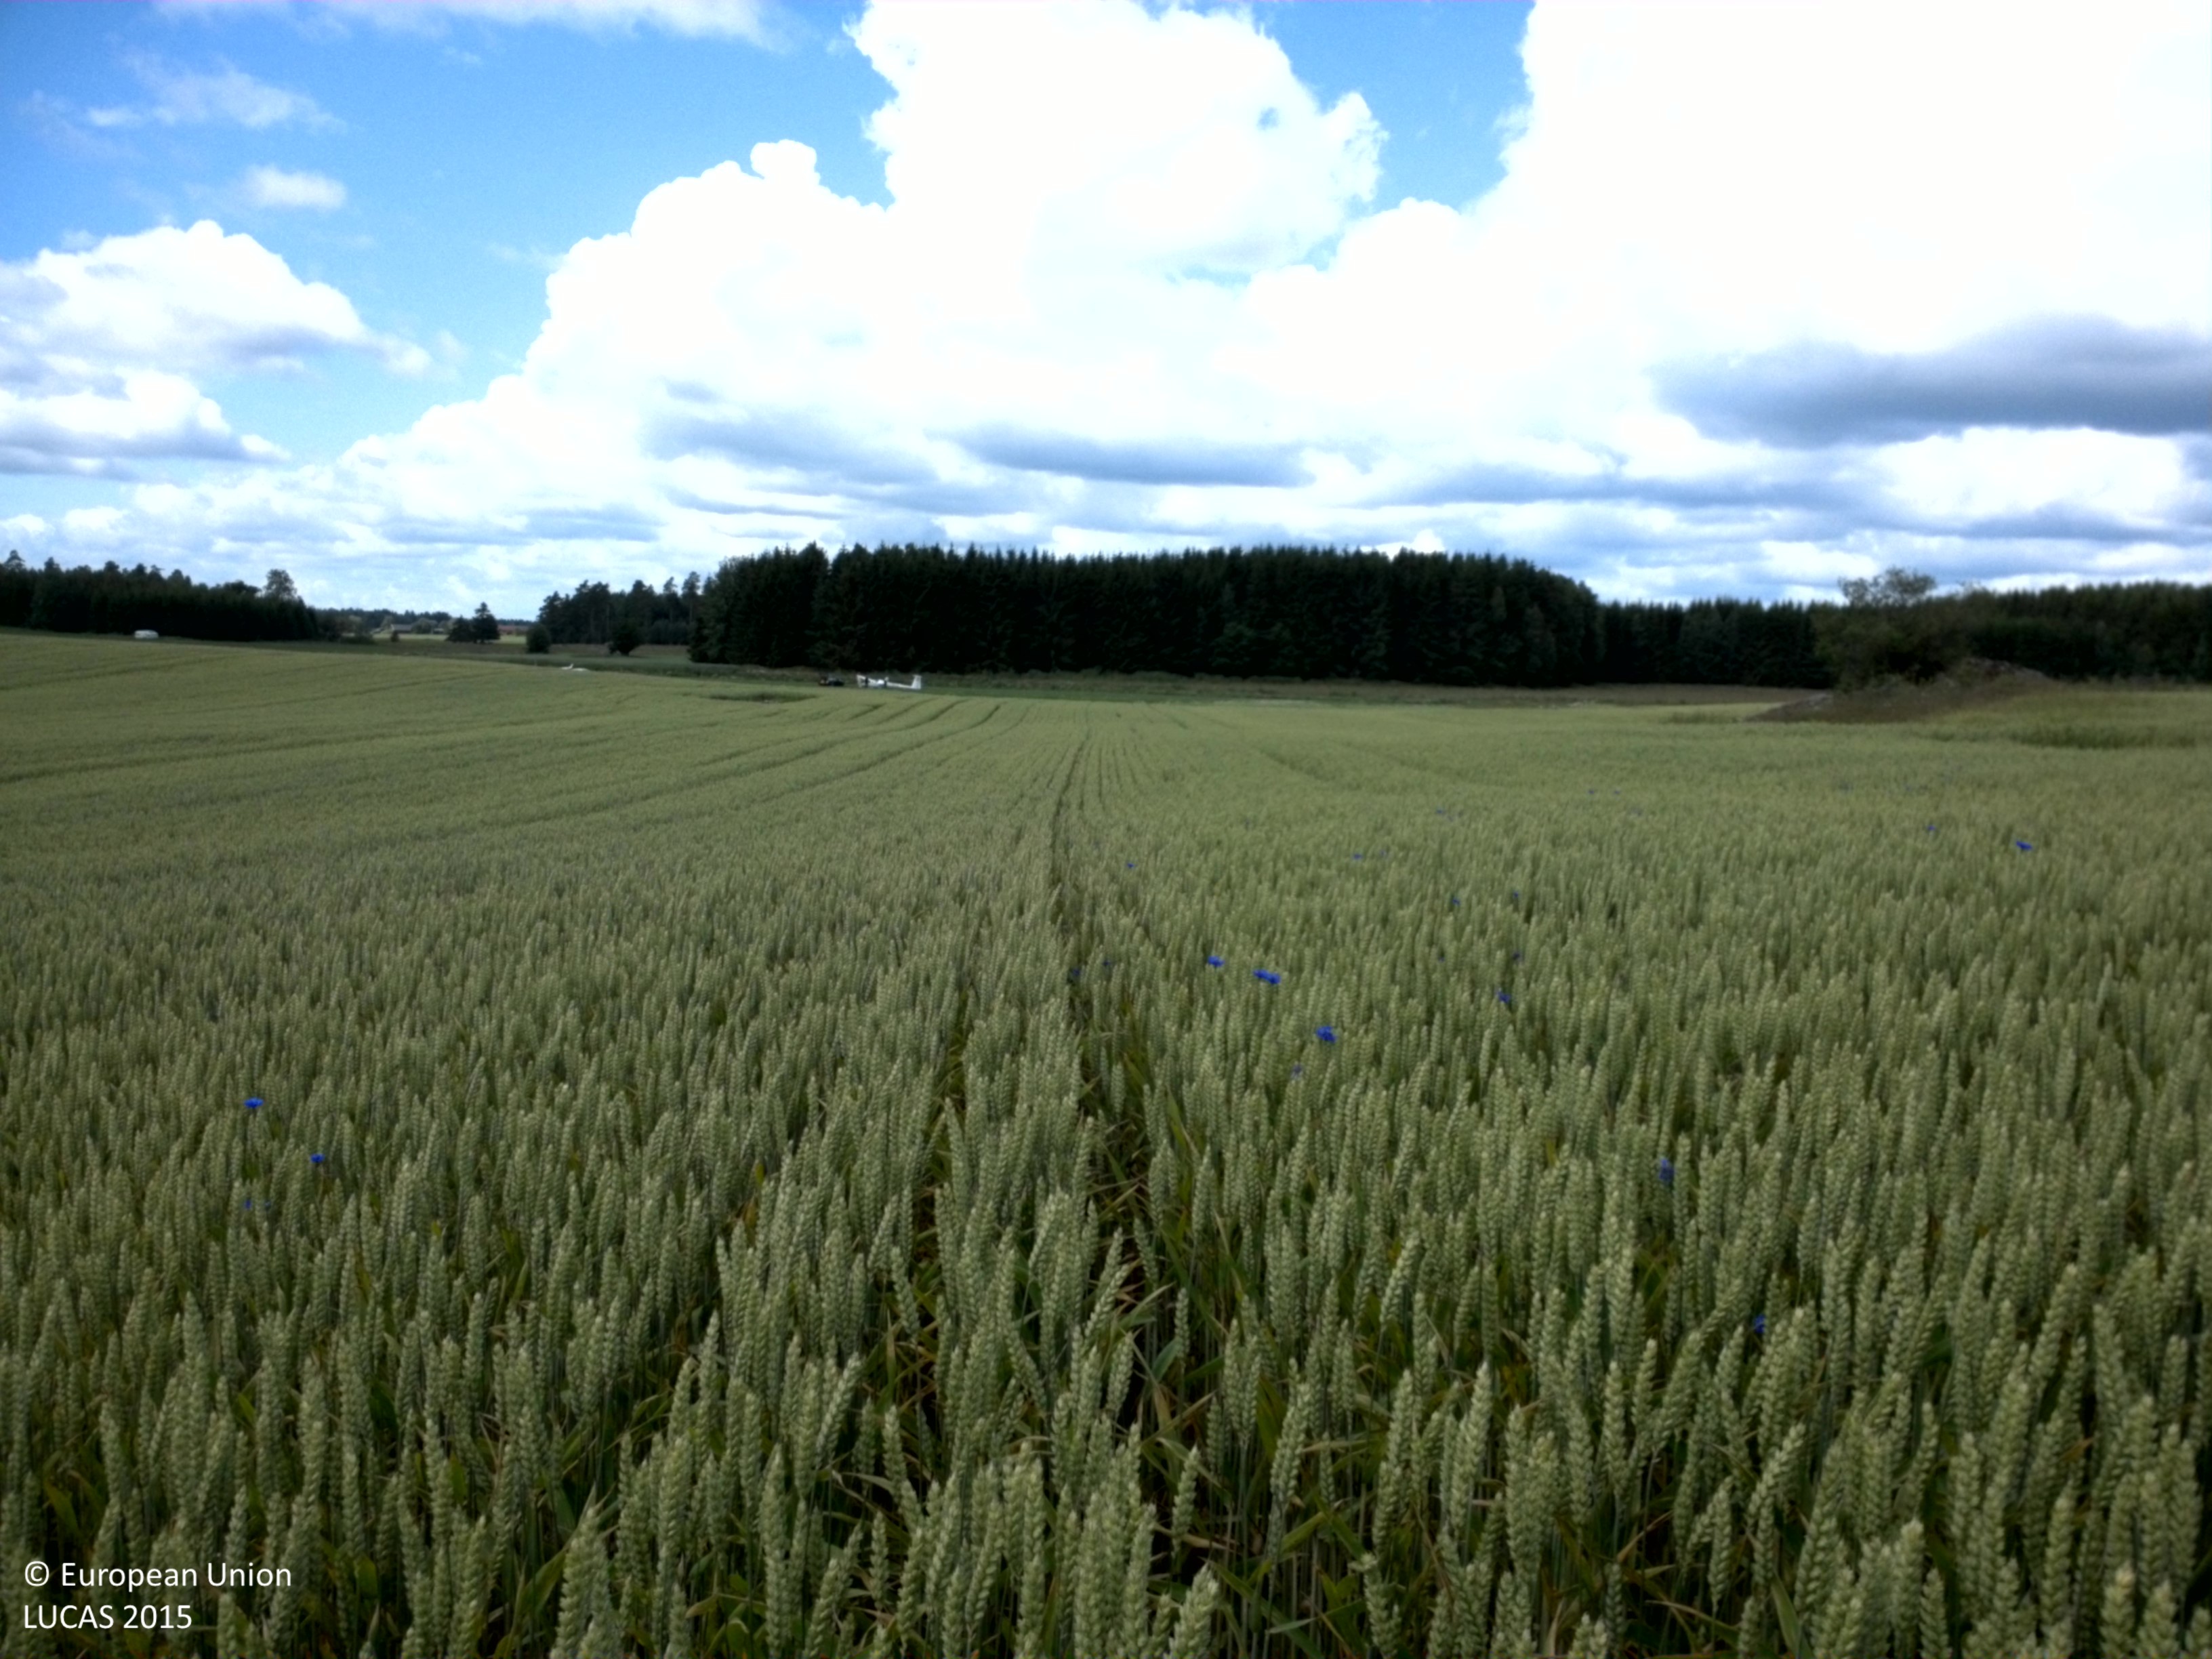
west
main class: Cropland
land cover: Common wheat
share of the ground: > 75 %
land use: Agriculture (excluding fallow land and kitchen gardens)
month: July
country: SE
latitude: 58.7339
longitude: 15.6077
